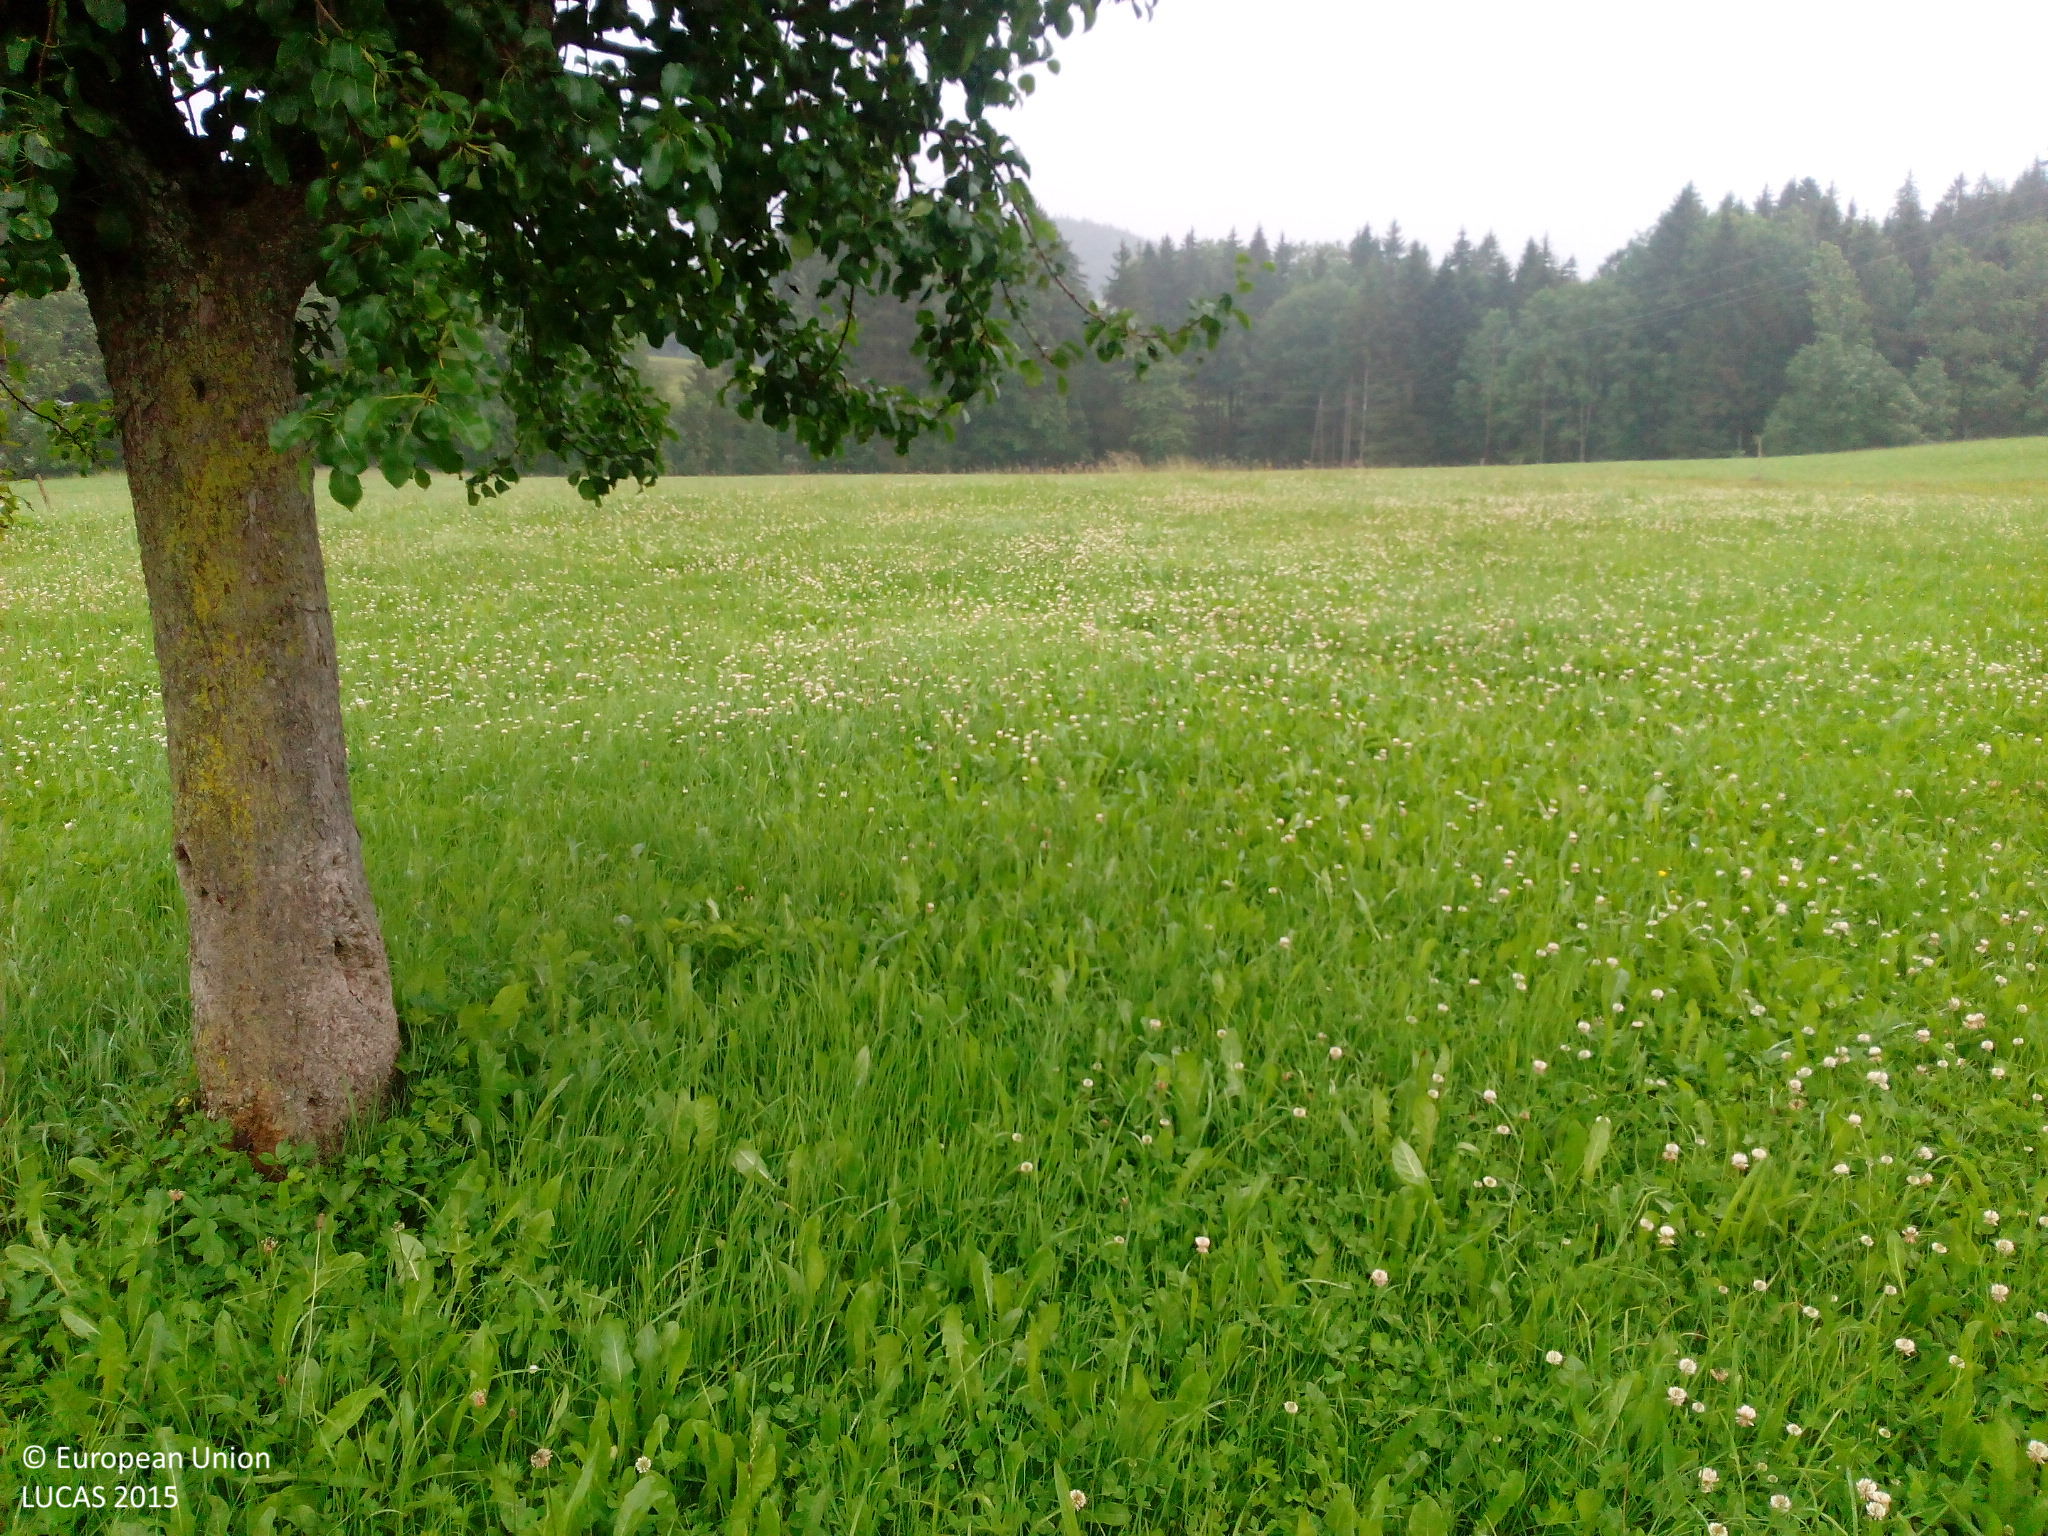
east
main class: Grassland
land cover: Grassland with sparse tree/shrub cover
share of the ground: > 75 %
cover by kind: herbaceous plants 95 %, broadleaved forest trees 5 %
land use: Agriculture (excluding fallow land and kitchen gardens)
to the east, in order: Grassland with sparse tree/shrub cover; Grassland without tree/shrub cover; Tracks; Grassland without tree/shrub cover; Broadleaved woodland; Rivers and streams; Other mixed woodland; Rivers and streams; Other mixed woodland; Fences; Other mixed woodland
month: June
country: DE
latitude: 47.7373
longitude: 10.2532
